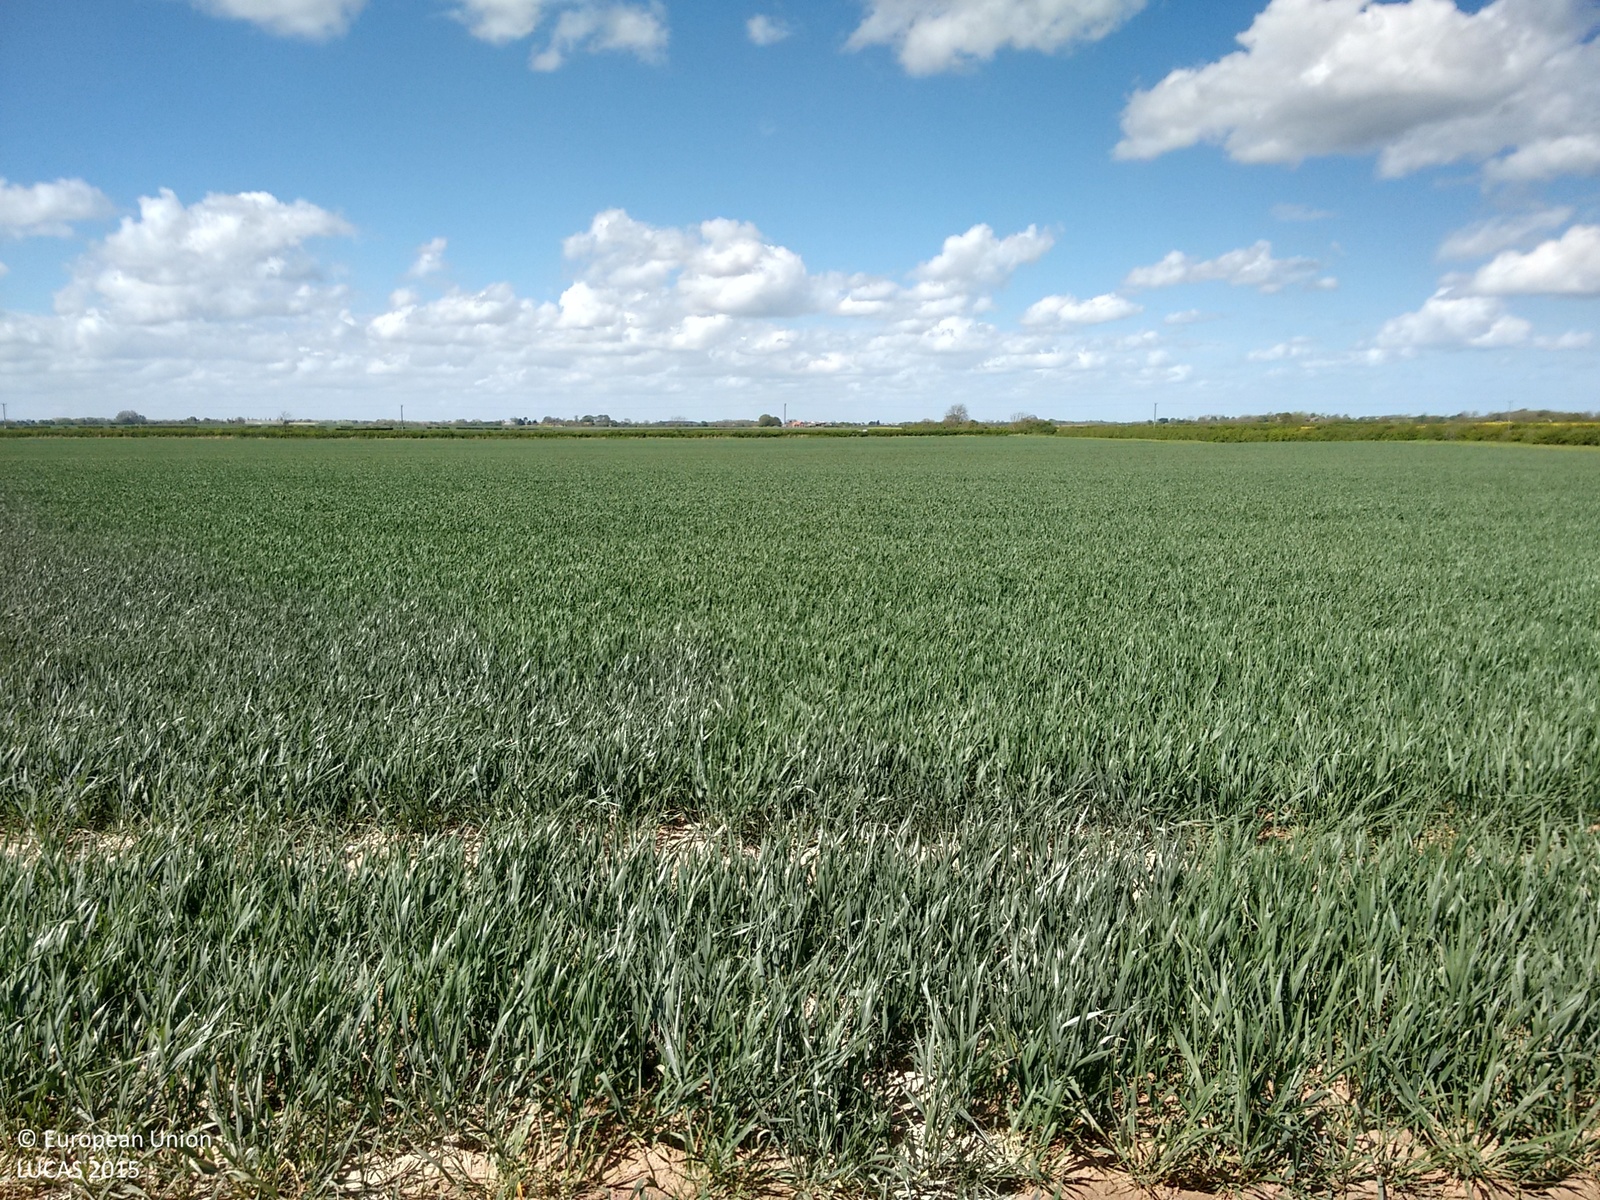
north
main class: Cropland
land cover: Common wheat
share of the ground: > 75 %
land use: Agriculture (excluding fallow land and kitchen gardens)
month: May
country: GB
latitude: 53.8706
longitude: -0.2694
